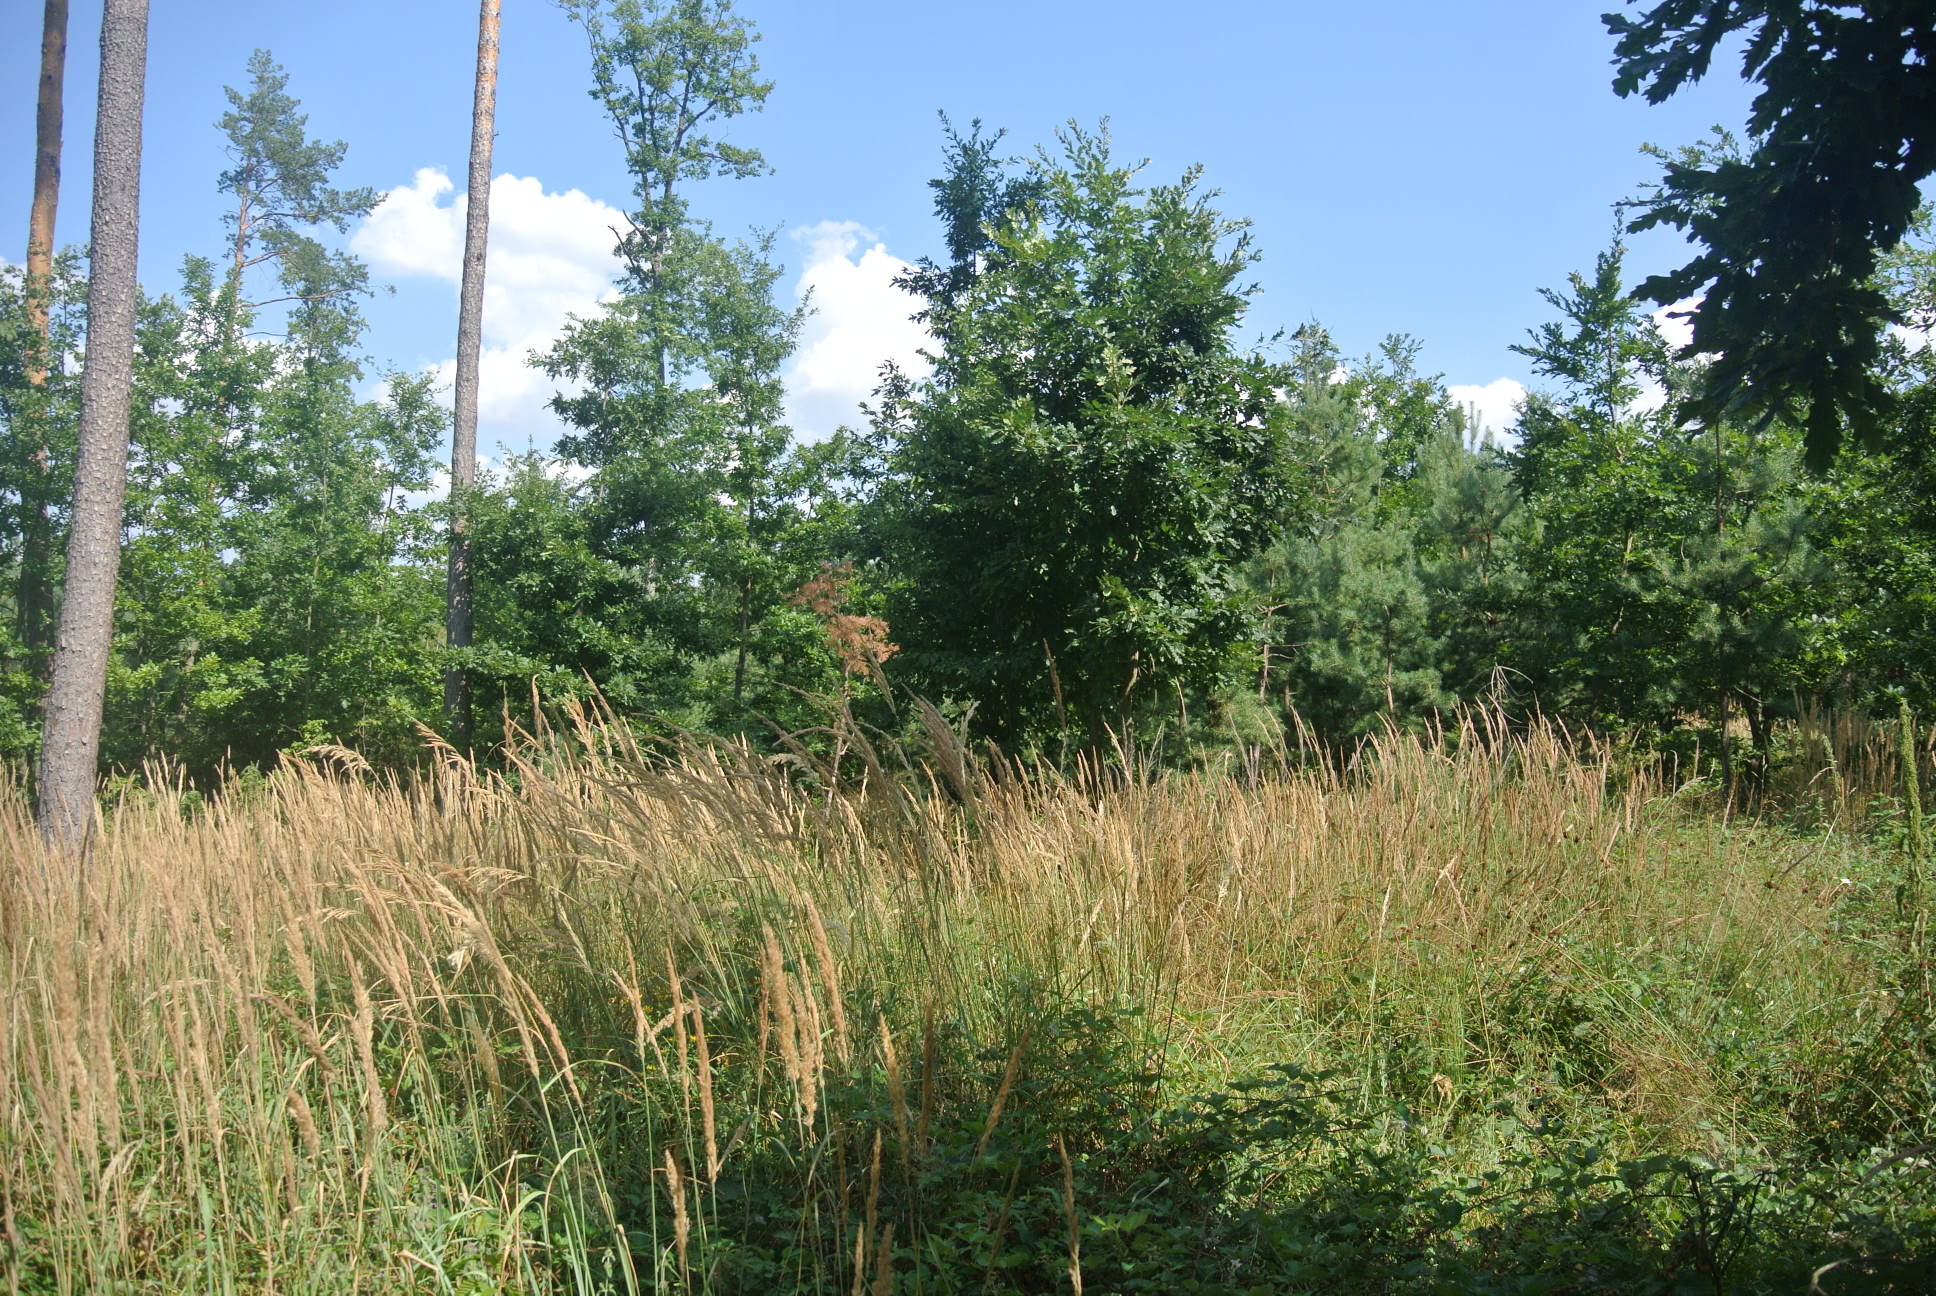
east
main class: Woodland
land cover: Pine dominated mixed woodland
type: acidophilous oak and oak-birch forest
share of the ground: > 75 %
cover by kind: coniferous forest trees 40 %, broadleaved forest trees 35 %, herbaceous plants 25 %
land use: Forestry
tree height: > 5 m
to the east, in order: Pine dominated mixed woodland; Tracks; Pine dominated mixed woodland; Tracks; Pine dominated mixed woodland
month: July
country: AT
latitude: 47.5442
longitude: 16.5009
